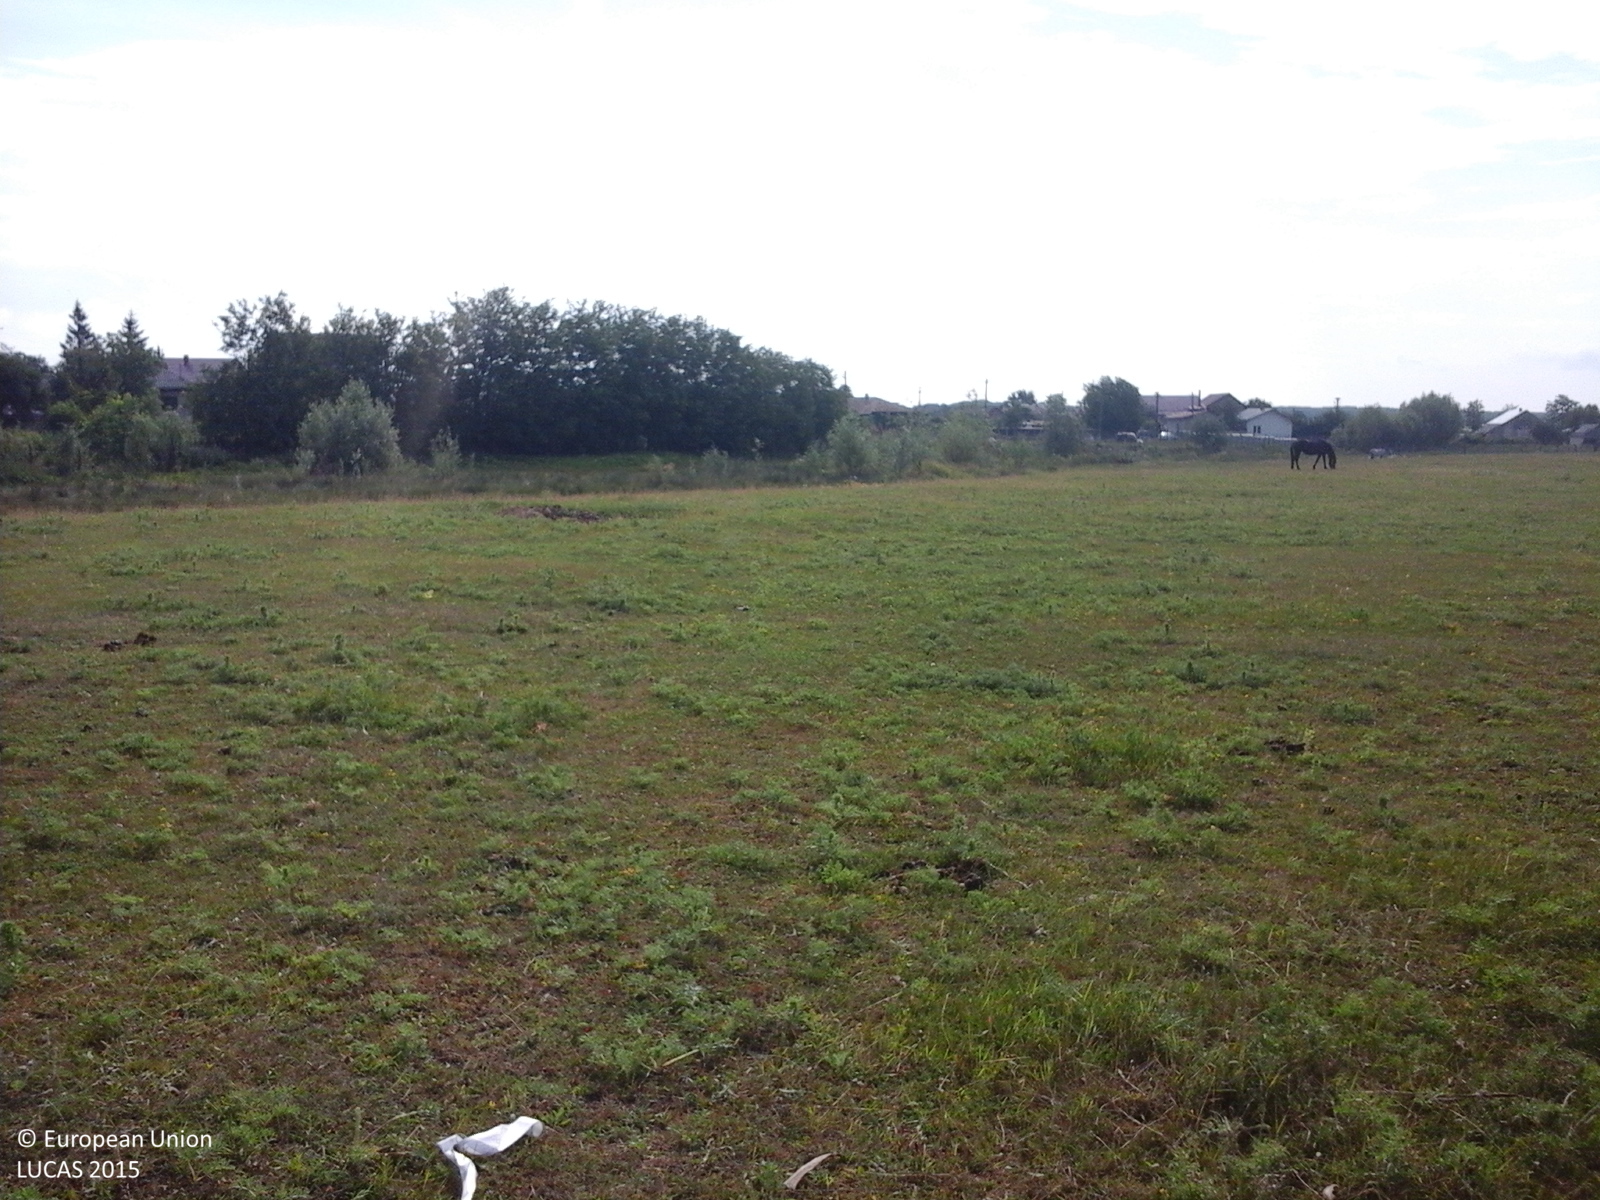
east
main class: Grassland
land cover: Grassland without tree/shrub cover
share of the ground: > 75 %
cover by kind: herbaceous plants 100 %
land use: Agriculture (excluding fallow land and kitchen gardens)
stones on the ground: < 10 %
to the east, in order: Grassland without tree/shrub cover; Ditches and canals; Broadleaved woodland; Artificial constructions in urban areas
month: June
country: RO
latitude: 47.0519
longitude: 26.9076
